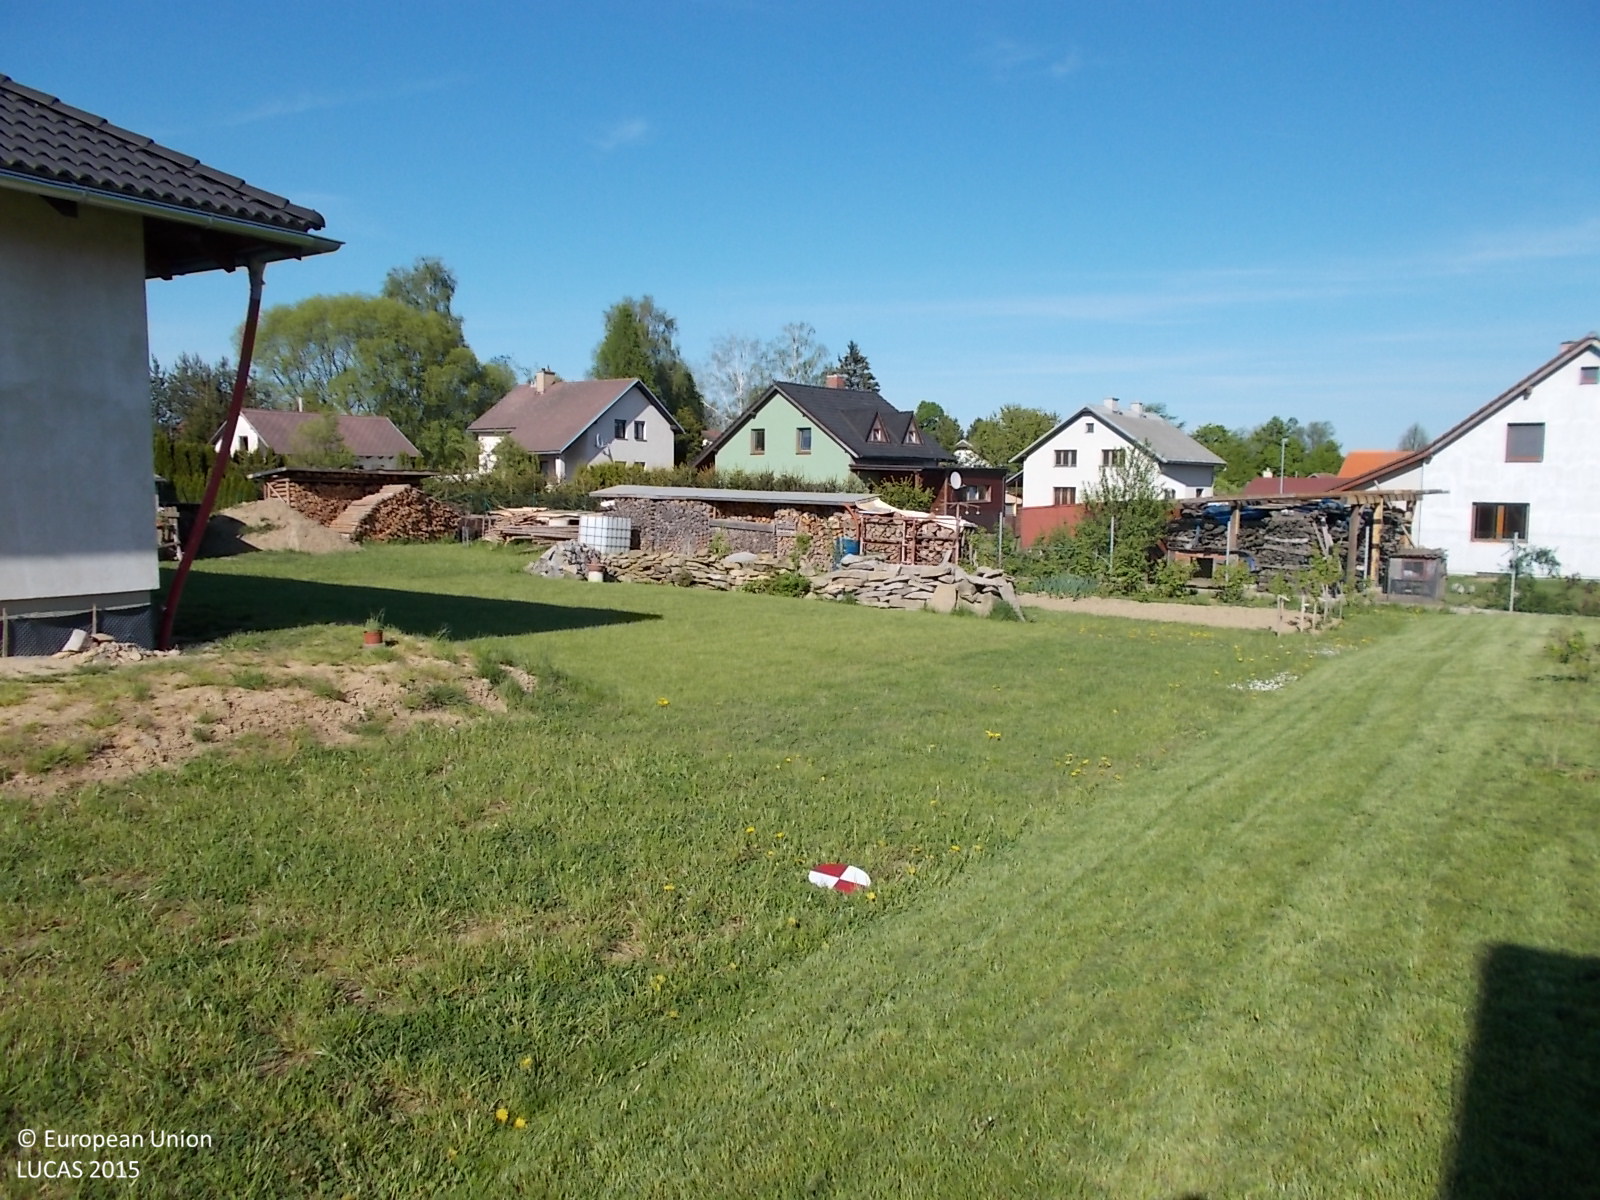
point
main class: Grassland
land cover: Grassland without tree/shrub cover
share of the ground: > 75 %
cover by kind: herbaceous plants 80 %
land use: Residential
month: May
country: CZ
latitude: 49.6301
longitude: 15.6391
